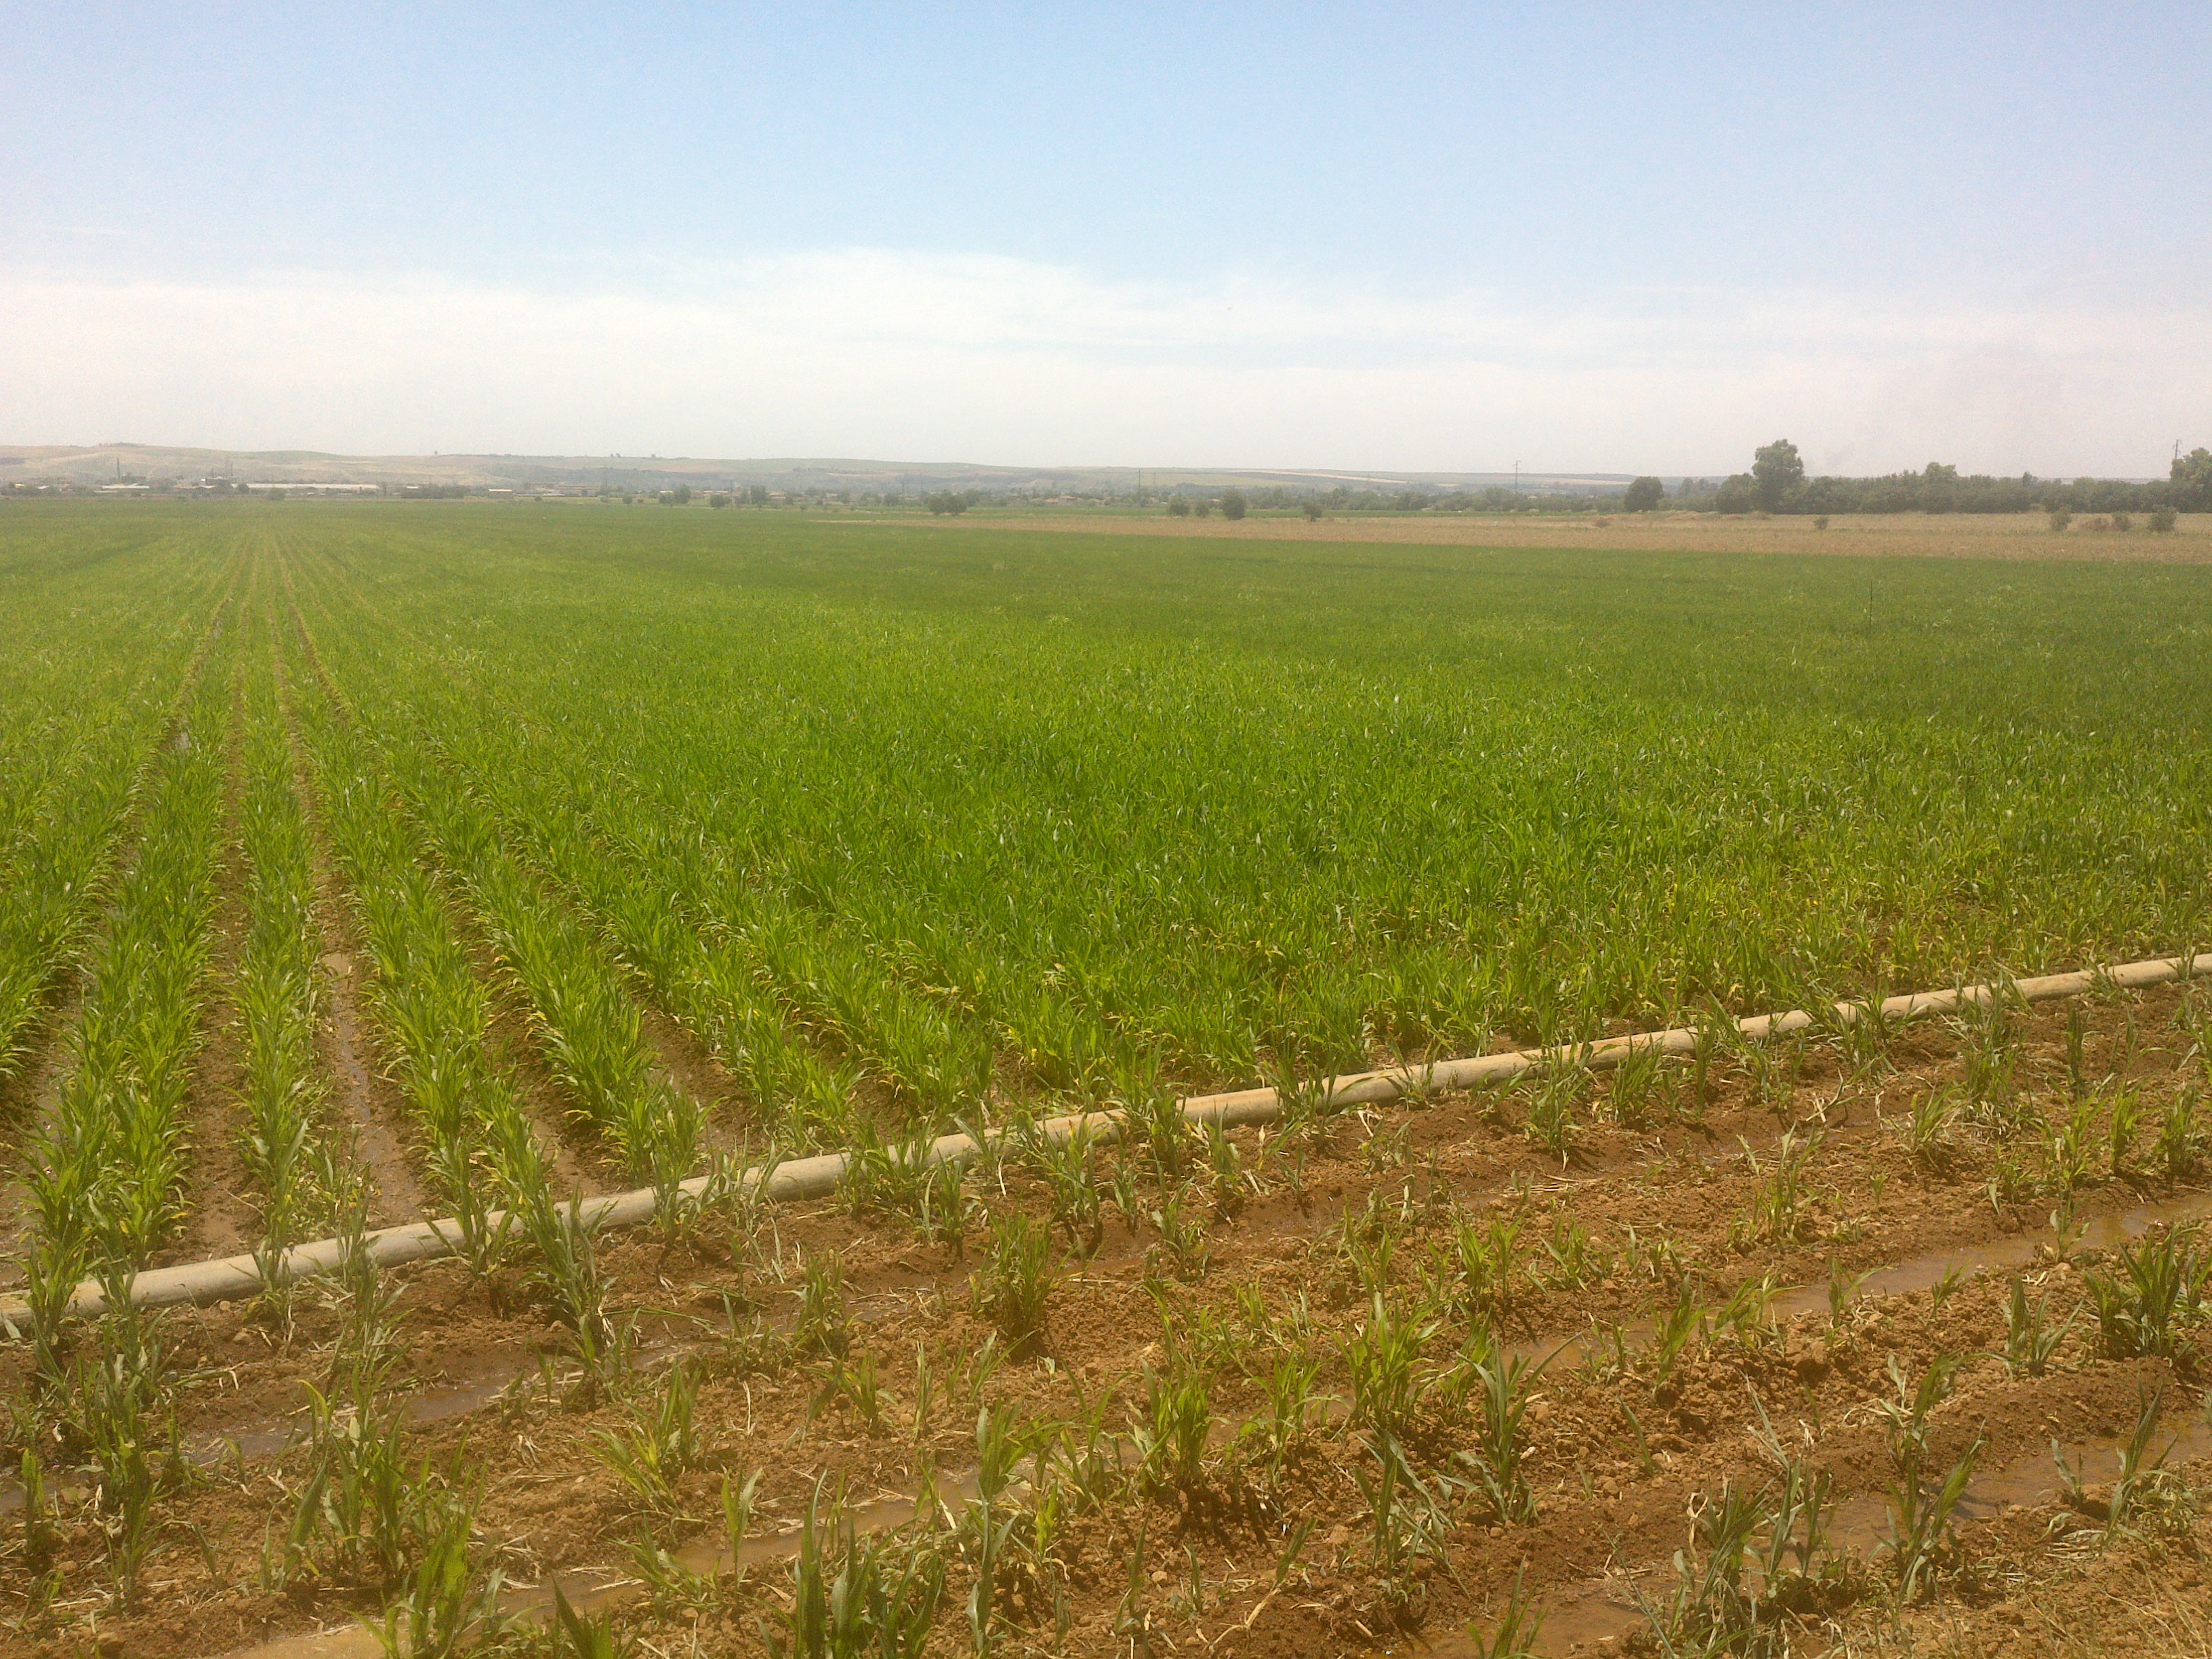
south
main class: Cropland
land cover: Maize
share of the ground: > 75 %
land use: Agriculture (excluding fallow land and kitchen gardens)
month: May
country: ES
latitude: 37.8697
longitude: -4.9193
